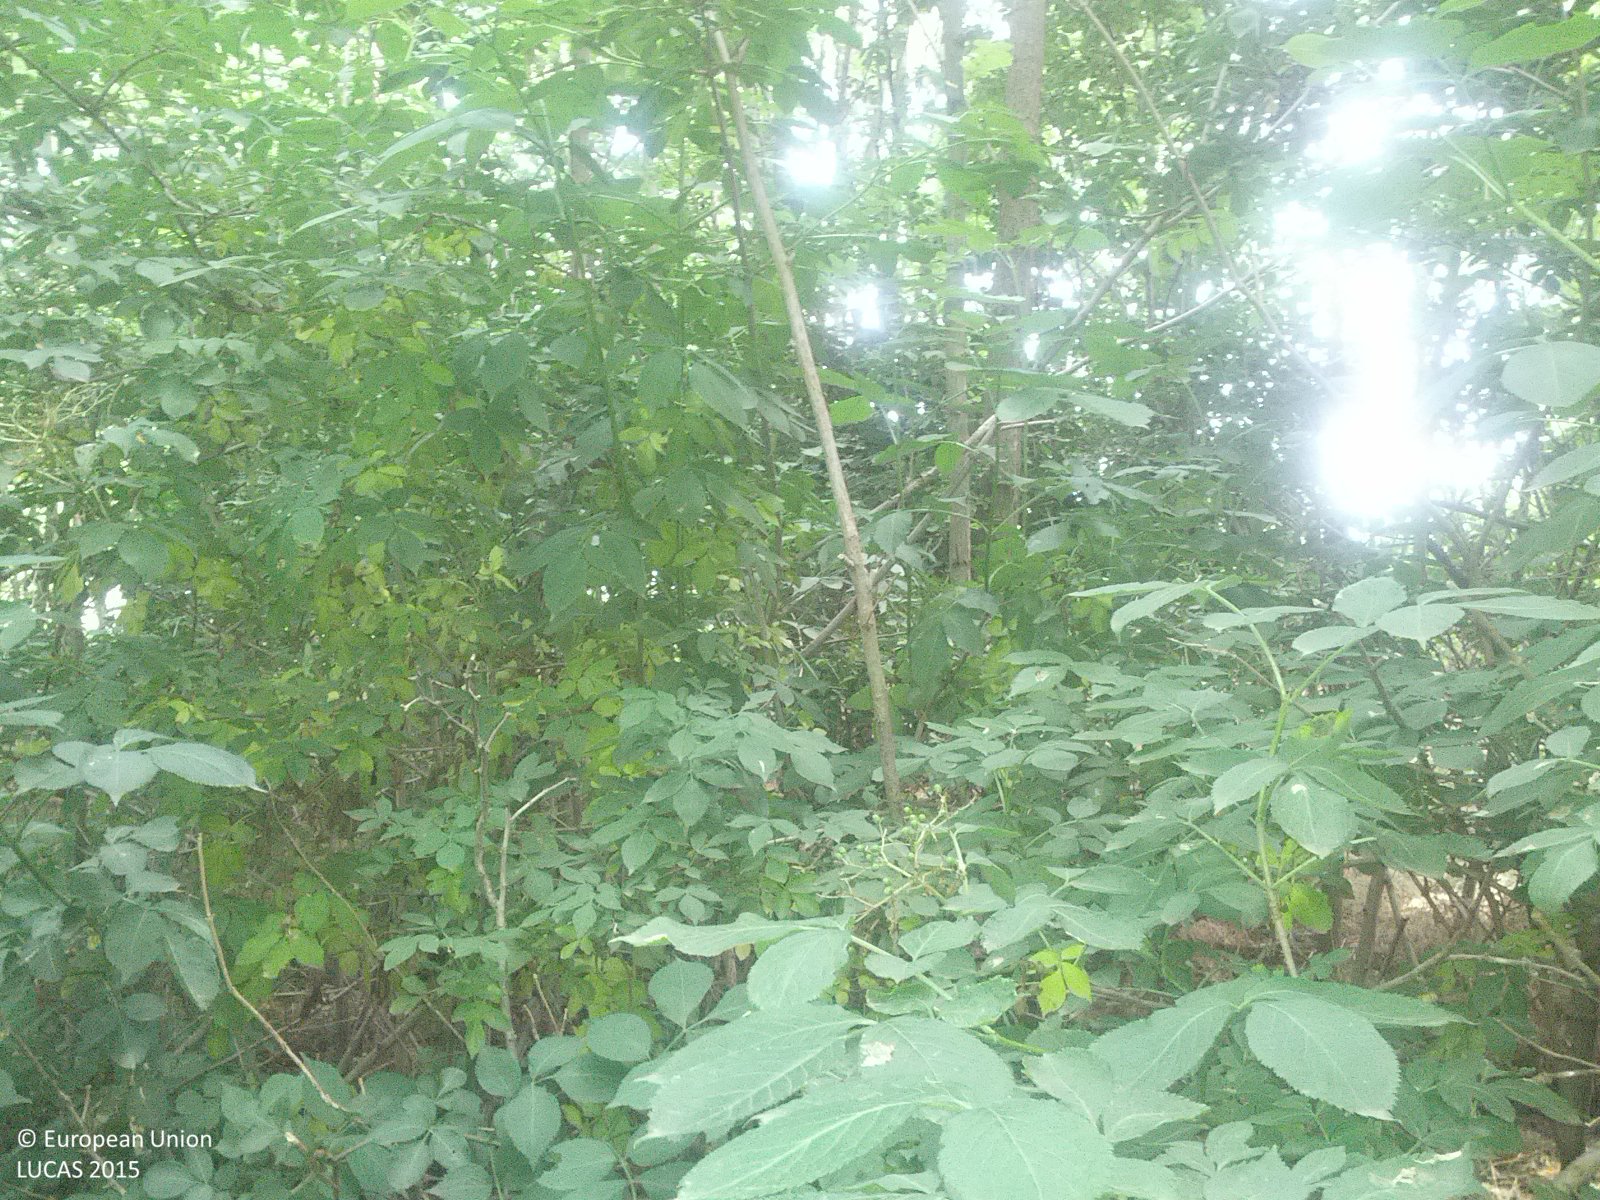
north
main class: Woodland
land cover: Broadleaved woodland
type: mesophytic deciduous forest
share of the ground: > 75 %
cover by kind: broadleaved forest trees 75 %, shrubs 10 %, herbaceous plants 10 %, lichens and mosses 5 %
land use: Forestry
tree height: > 5 m
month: June
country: AT
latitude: 48.3161
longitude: 16.8711
